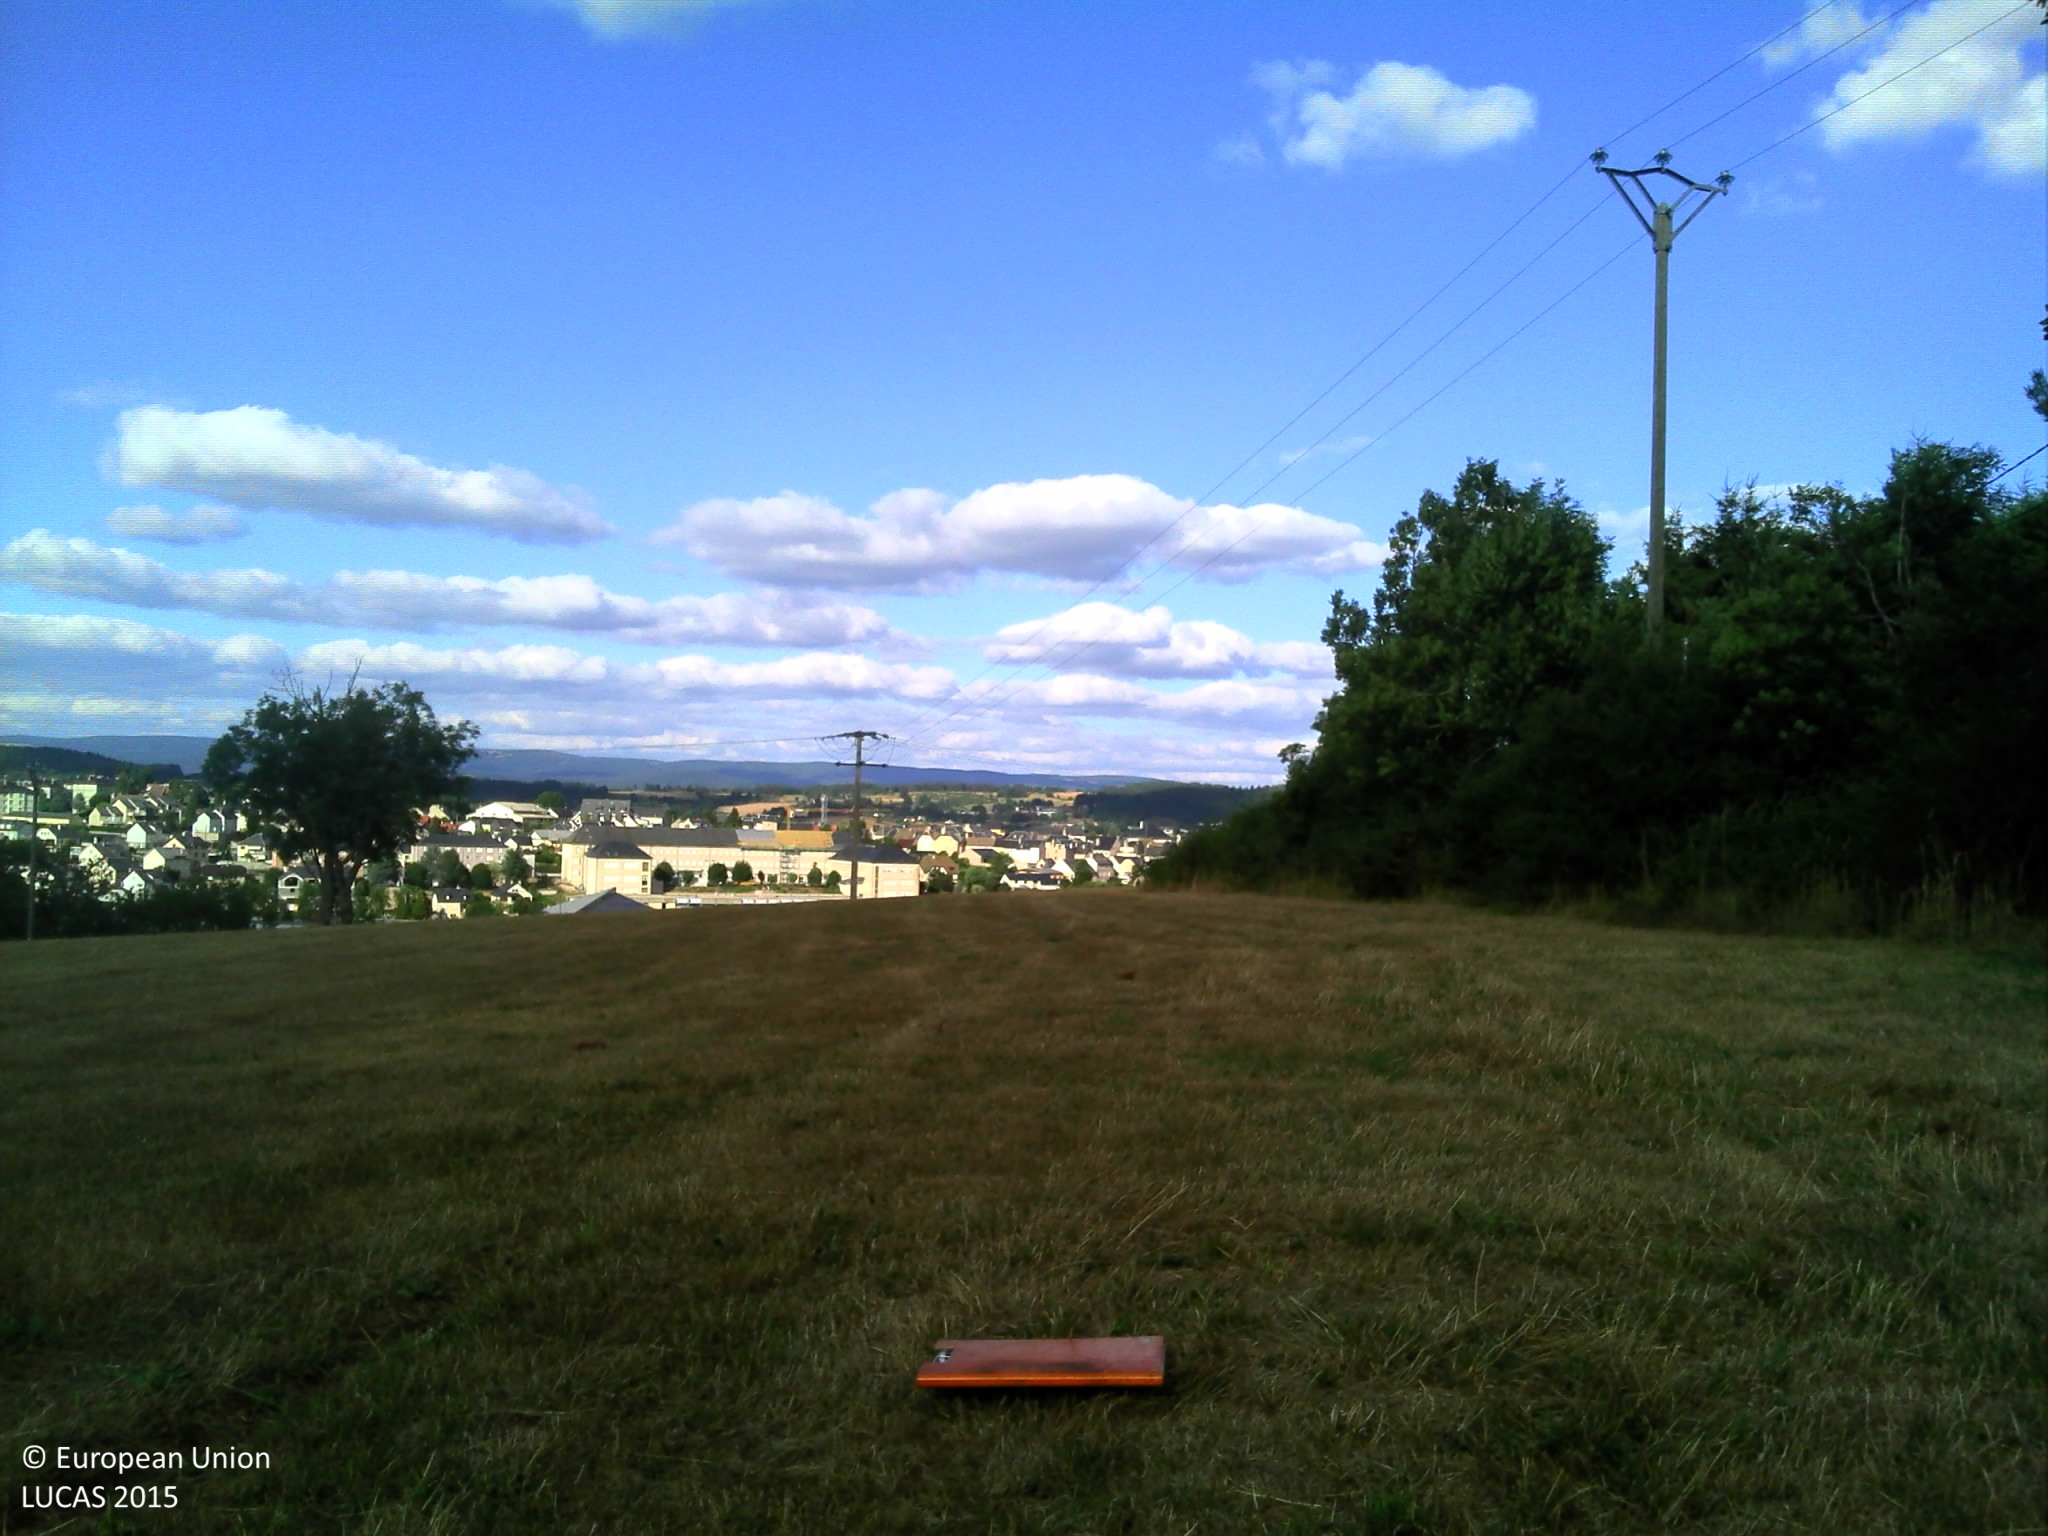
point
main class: Grassland
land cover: Grassland without tree/shrub cover
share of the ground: > 75 %
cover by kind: herbaceous plants 95 %, shrubs 5 %
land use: Agriculture (excluding fallow land and kitchen gardens)
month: July
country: FR
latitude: 44.8010
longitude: 3.2653
